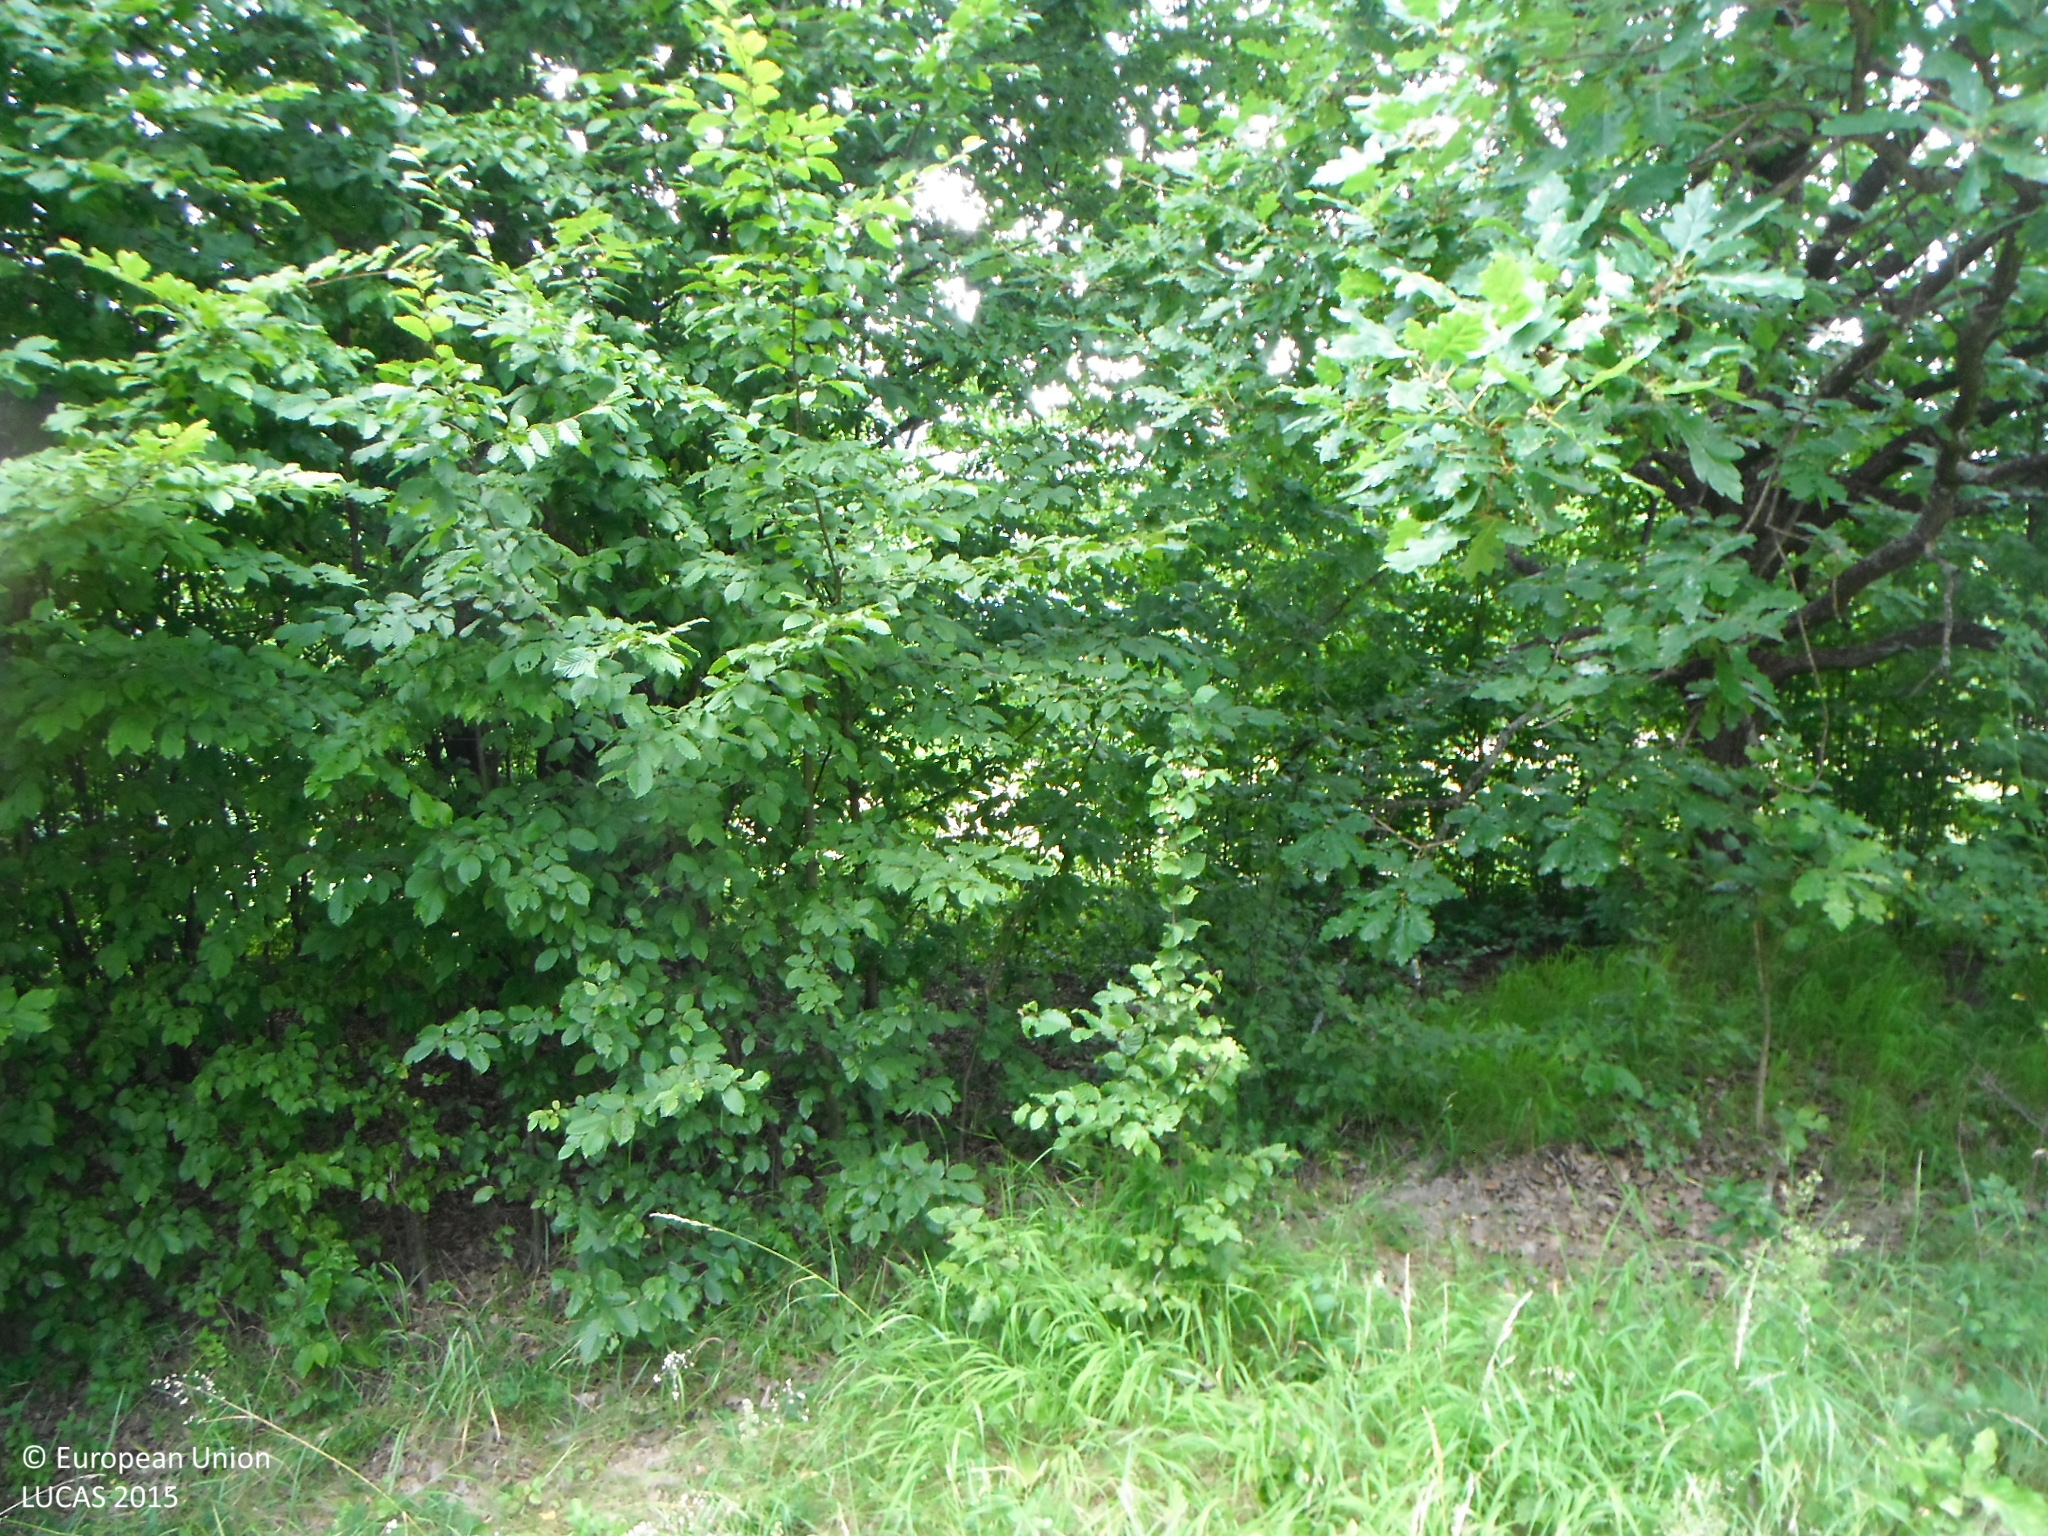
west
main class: Grassland
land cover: Grassland with sparse tree/shrub cover
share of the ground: > 75 %
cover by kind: herbaceous plants 85 %, shrubs 10 %, broadleaved forest trees 5 %
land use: Agriculture (excluding fallow land and kitchen gardens)
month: July
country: SK
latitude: 48.5071
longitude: 19.2130
